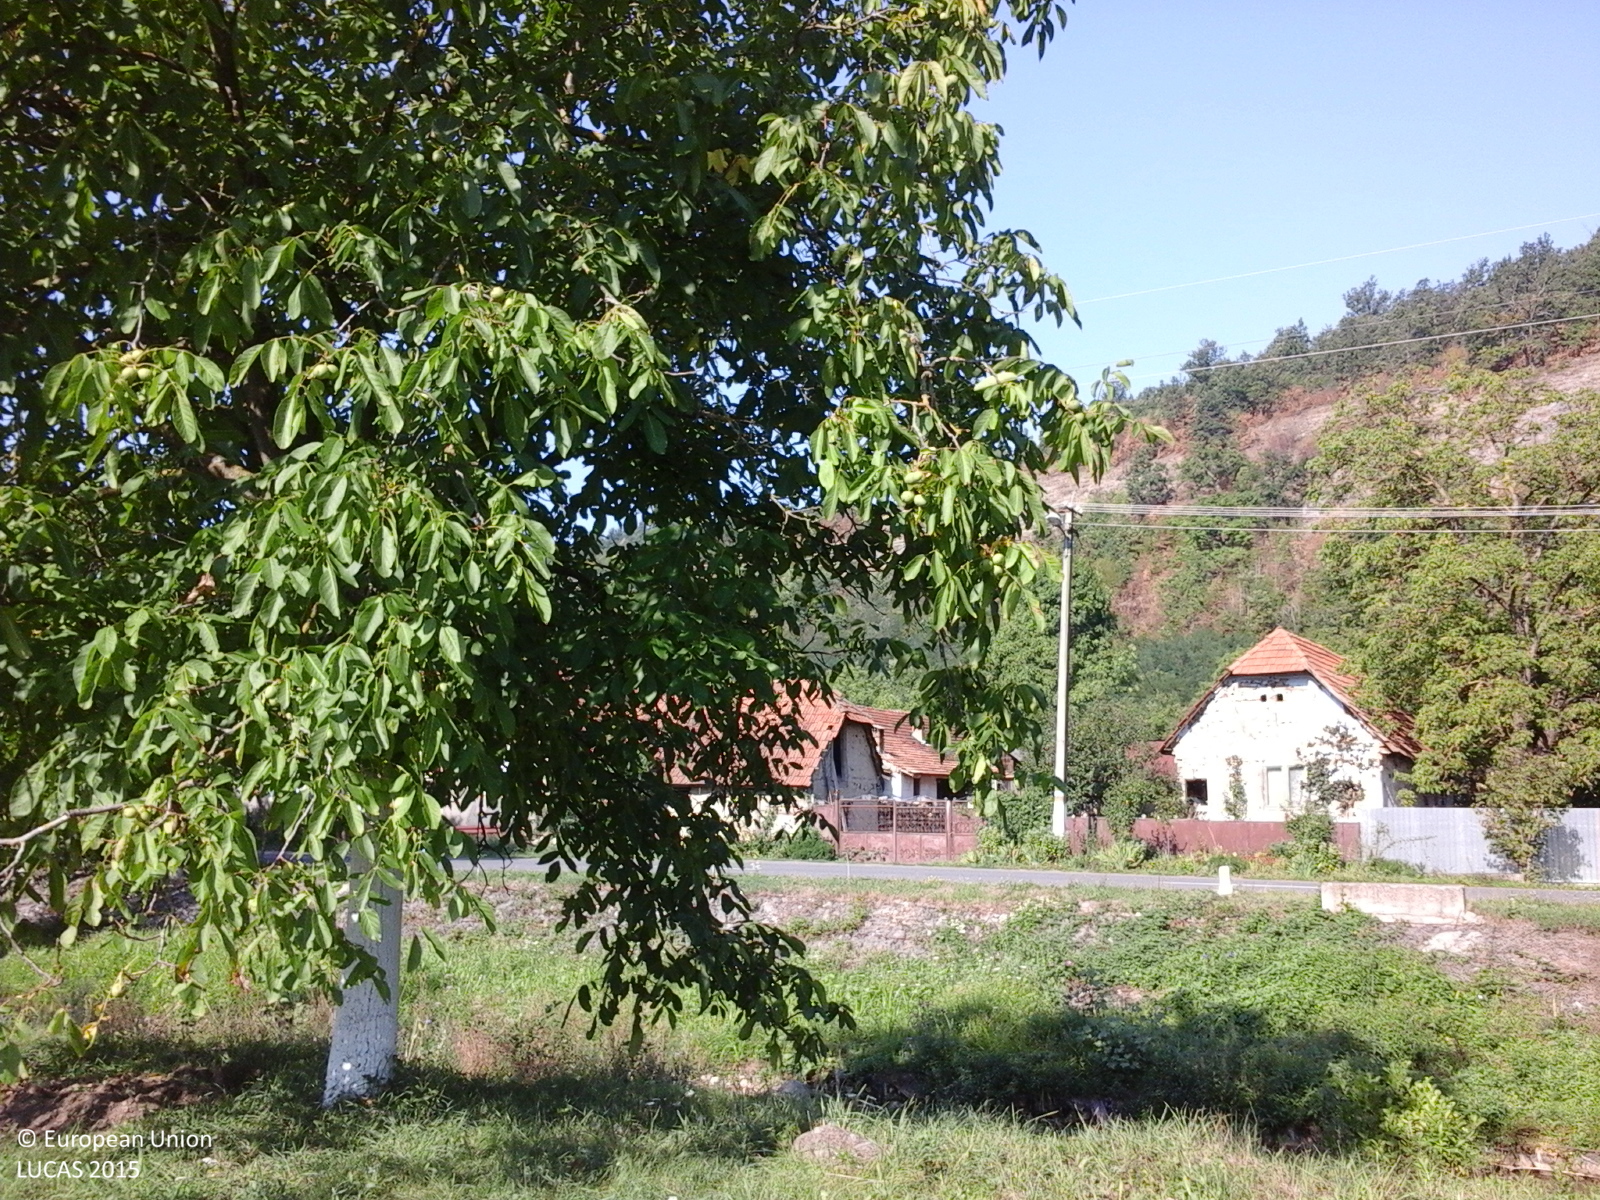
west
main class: Cropland
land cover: Other fruit trees and berries
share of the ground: 25 - 50 %
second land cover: Grassland without tree/shrub cover
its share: > 75 %
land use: Agriculture (excluding fallow land and kitchen gardens)
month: August
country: RO
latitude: 46.2182
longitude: 22.3237
